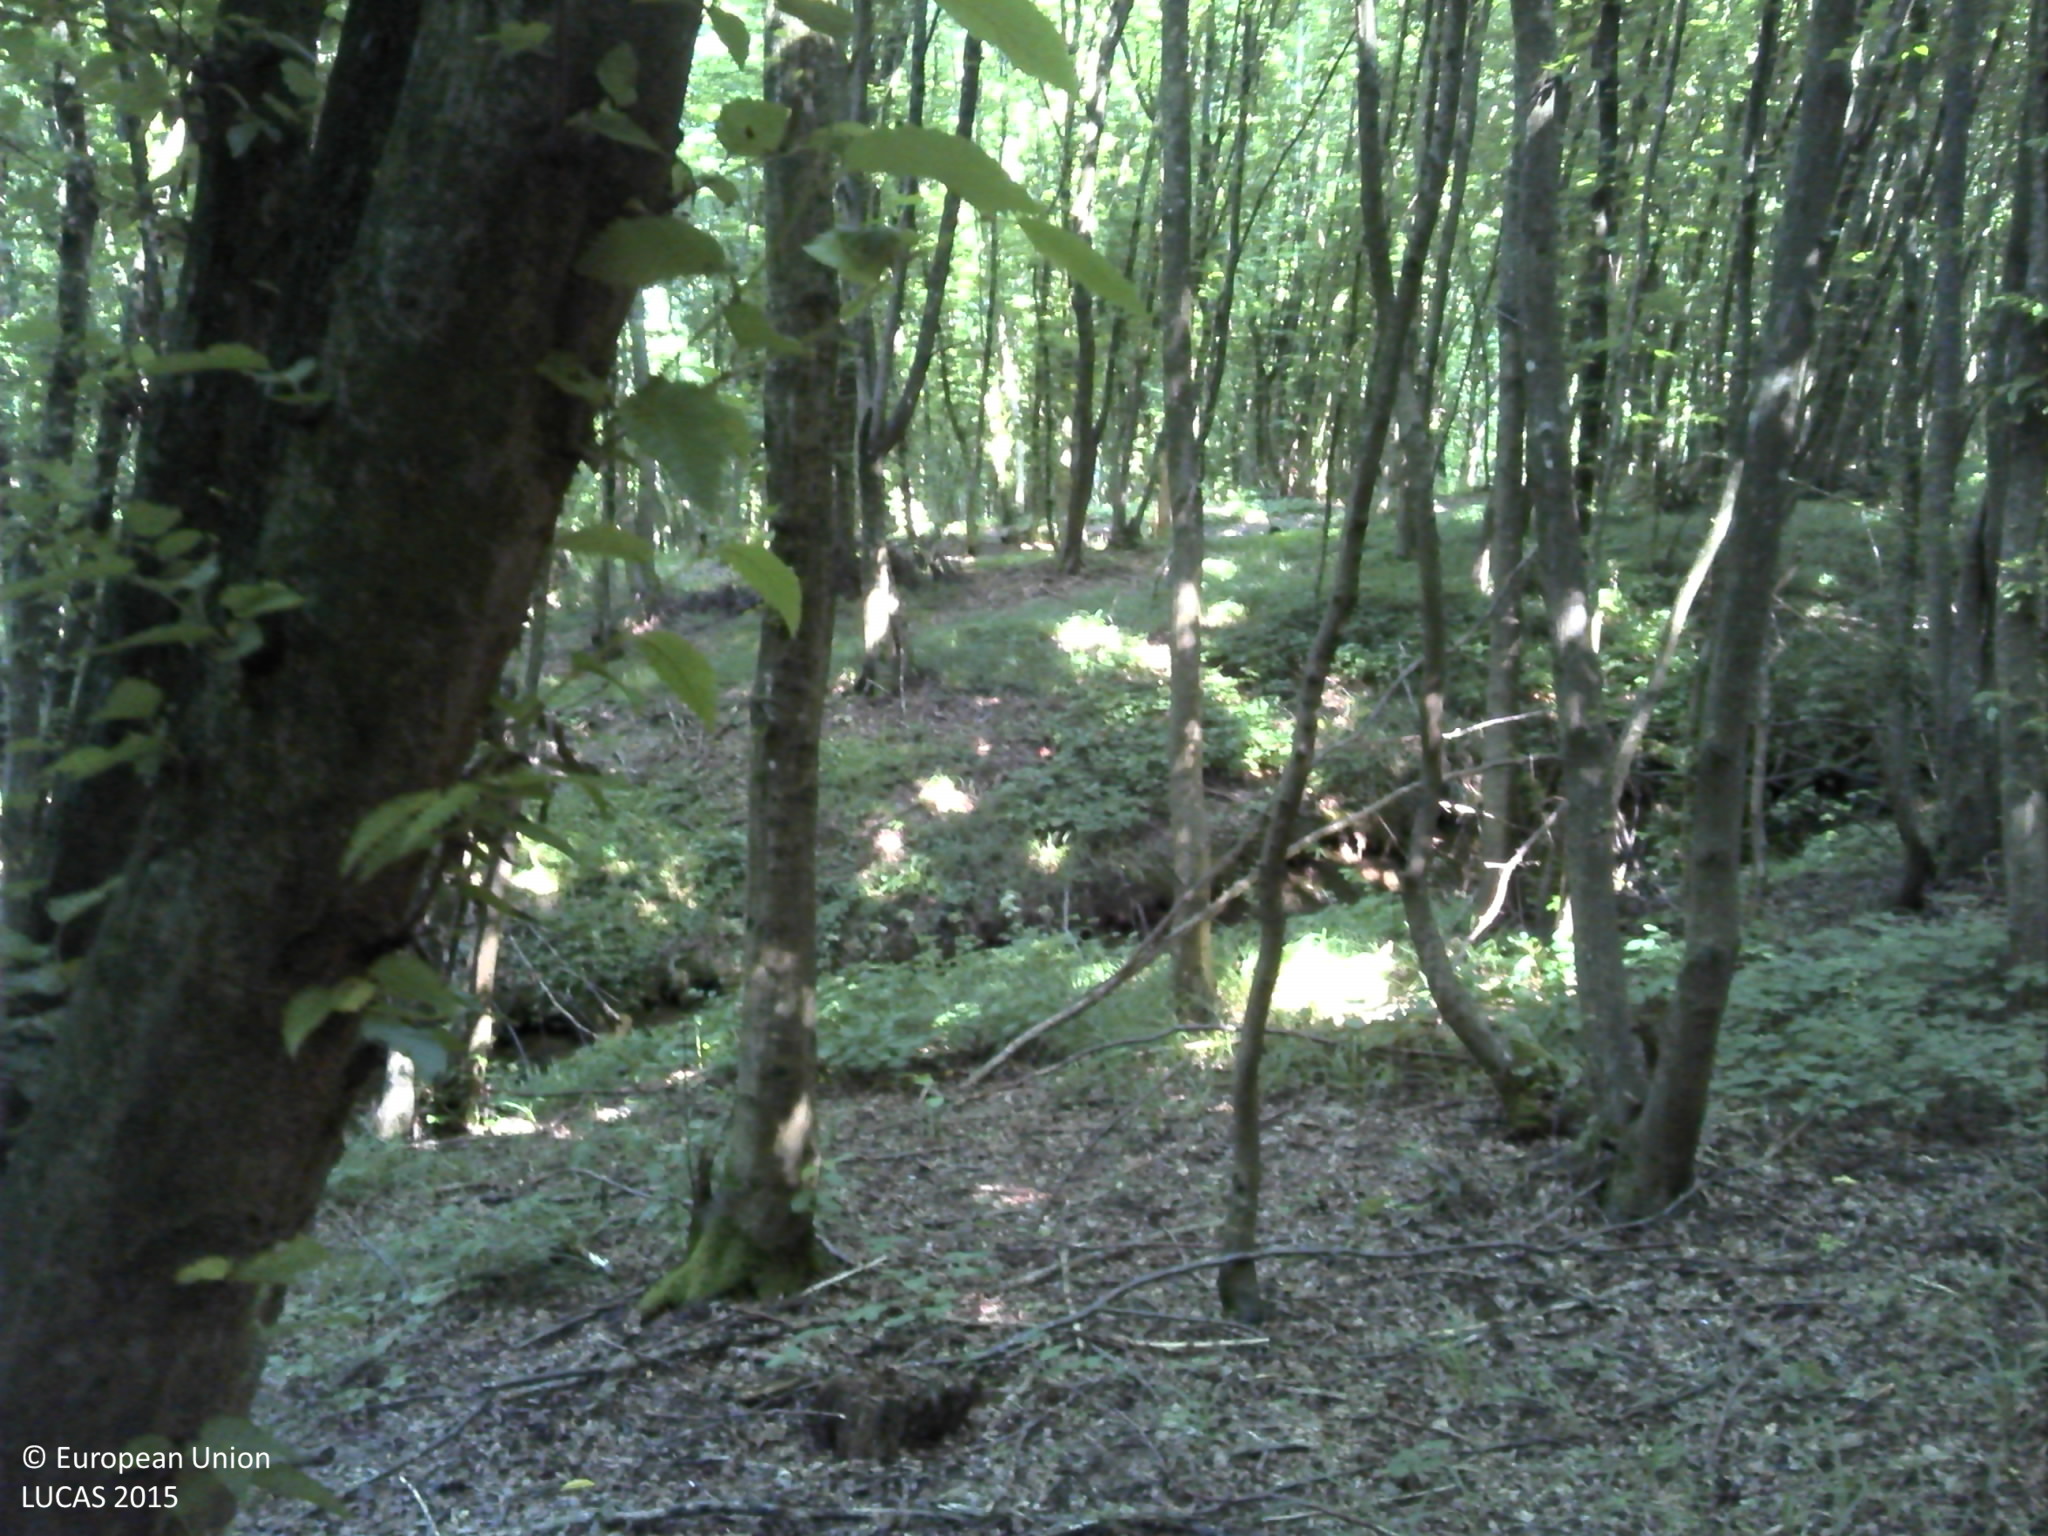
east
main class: Woodland
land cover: Broadleaved woodland
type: beech forest
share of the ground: > 75 %
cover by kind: broadleaved forest trees 80 %, lichens and mosses 20 %
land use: Forestry
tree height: > 5 m
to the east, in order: Broadleaved woodland; Rivers and streams; Barley; Grass margins; Maize
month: June
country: HR
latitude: 45.3714
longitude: 17.6500
